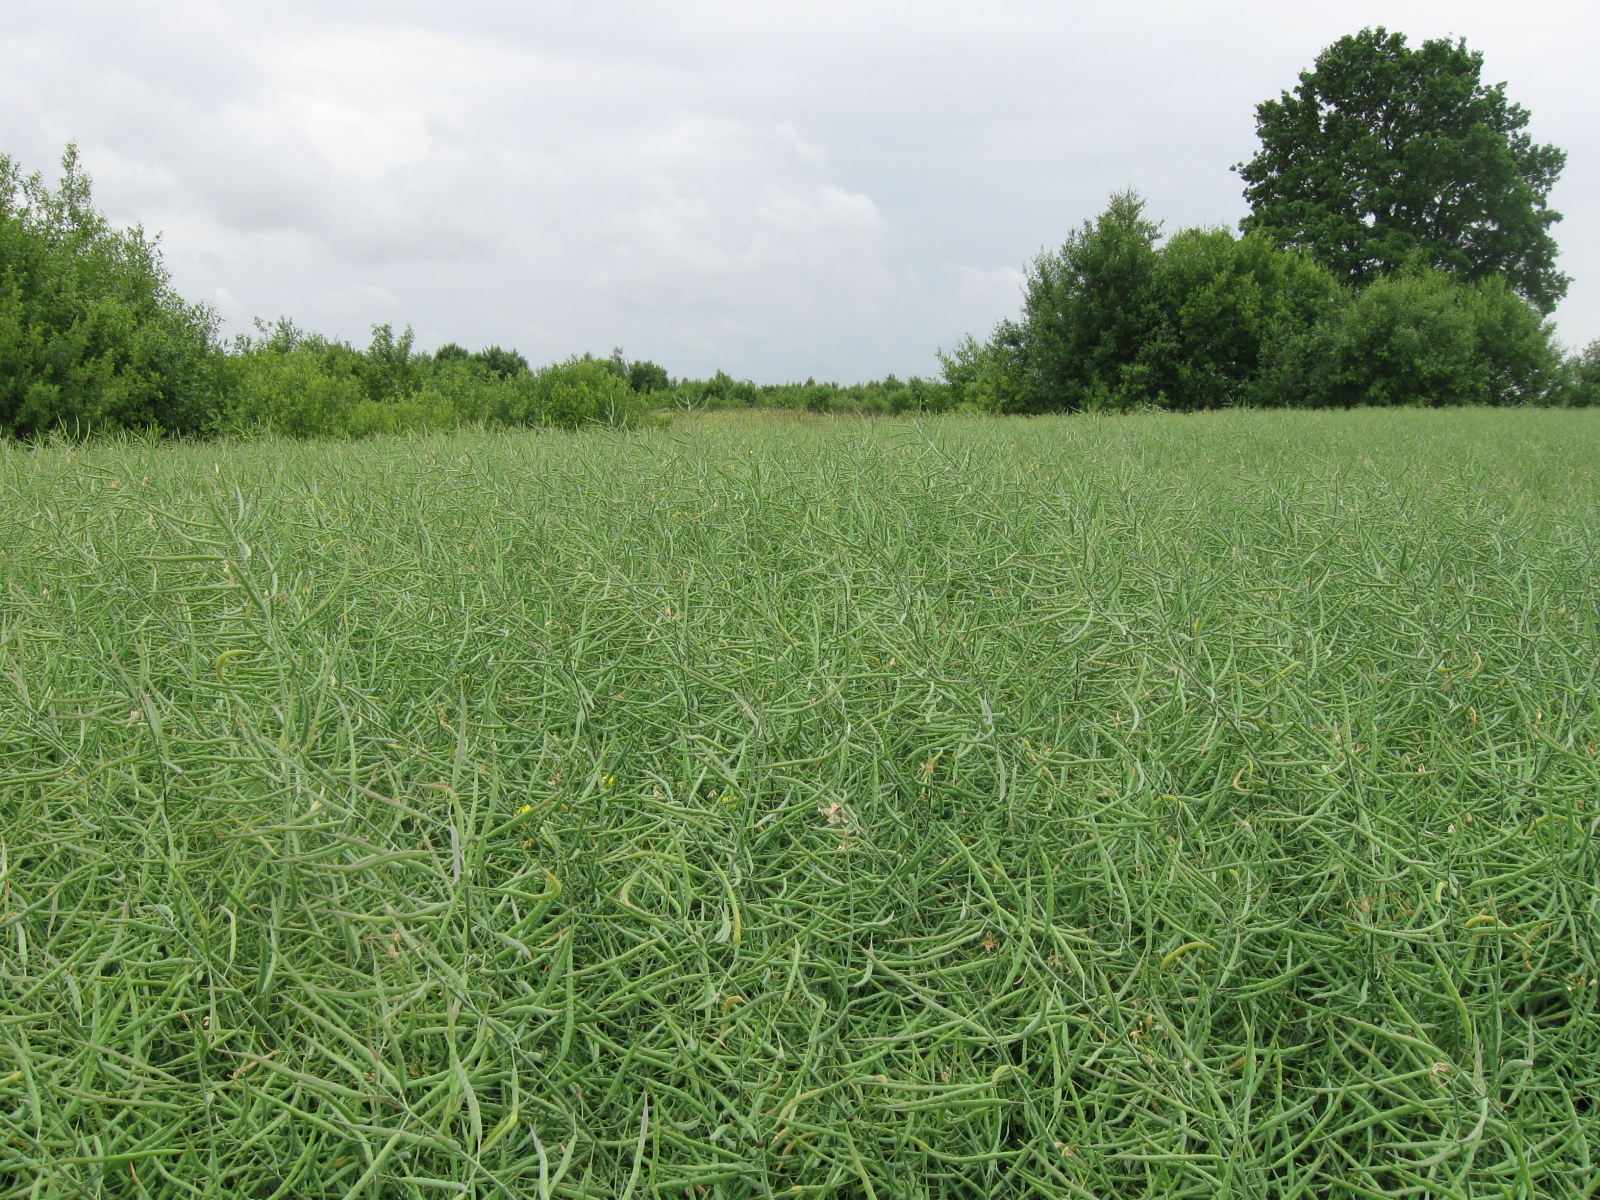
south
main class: Cropland
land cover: Rape and turnip rape
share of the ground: > 75 %
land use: Agriculture (excluding fallow land and kitchen gardens)
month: June
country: LT
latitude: 54.8937
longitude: 24.5569
